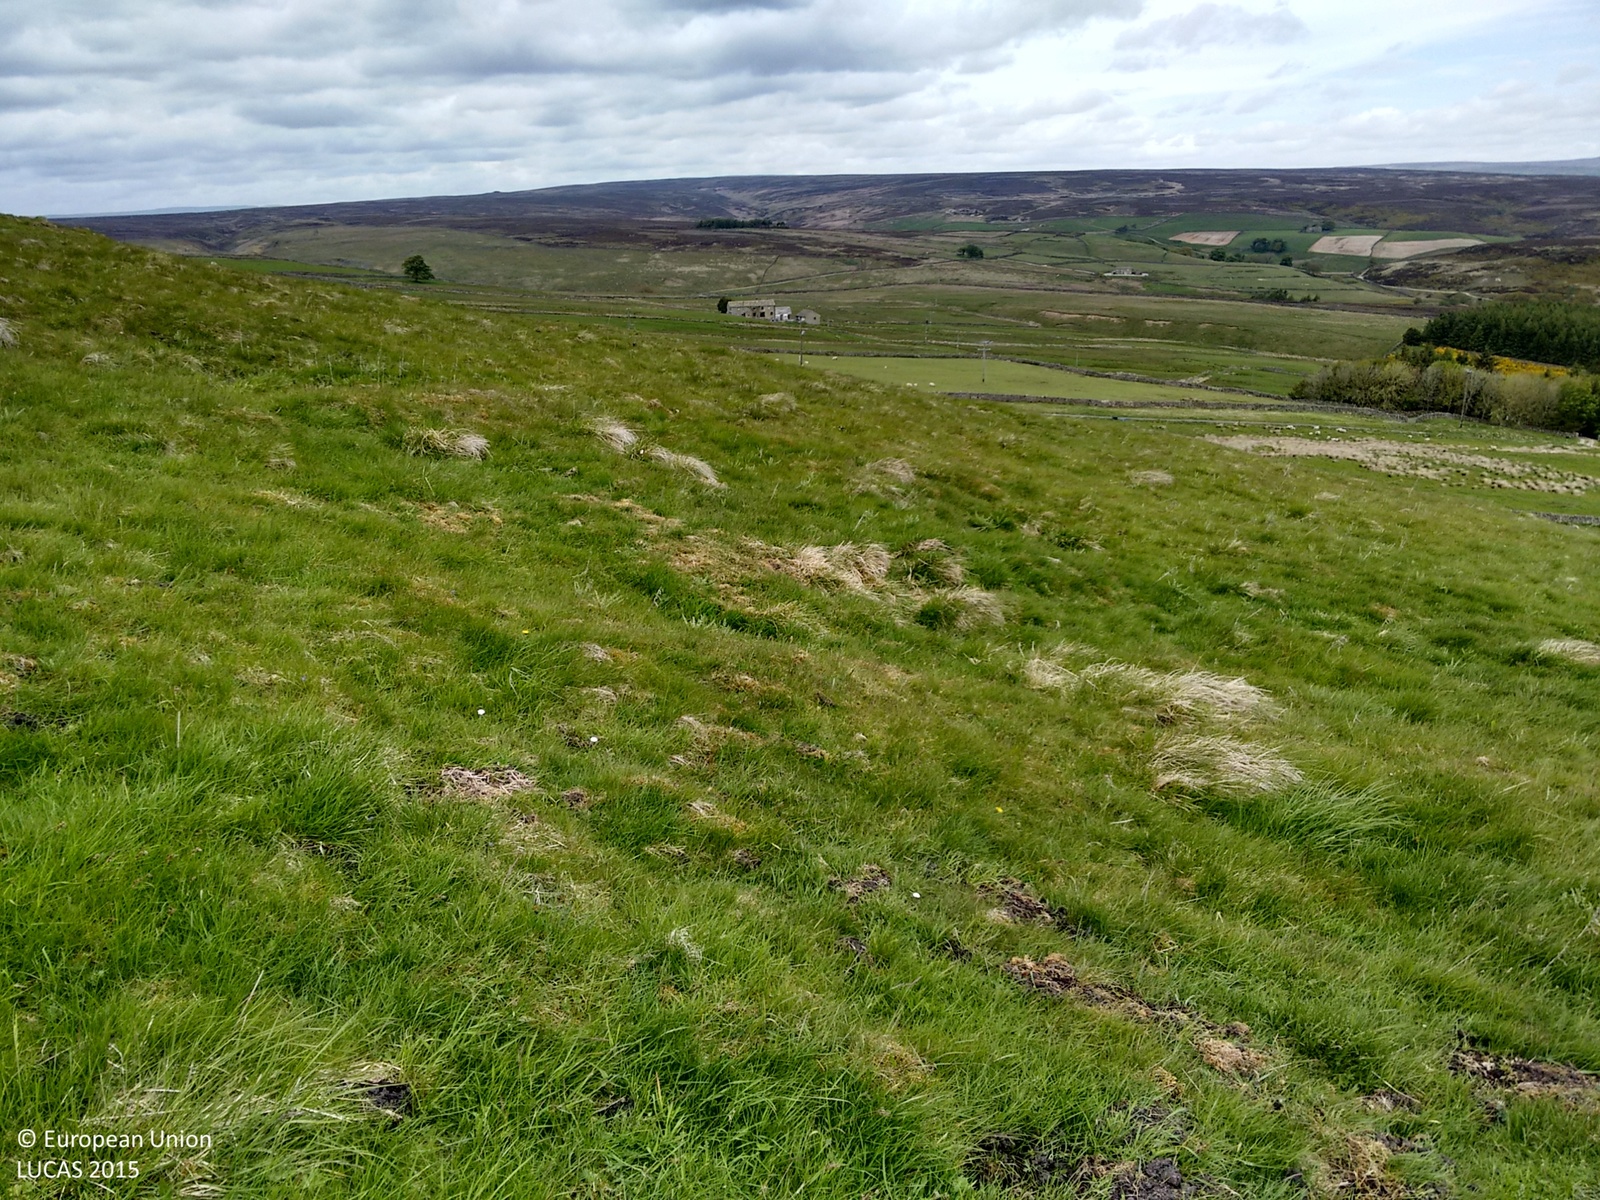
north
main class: Grassland
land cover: Grassland without tree/shrub cover
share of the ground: > 75 %
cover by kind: herbaceous plants 100 %
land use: Agriculture (excluding fallow land and kitchen gardens)
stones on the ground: < 10 %
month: June
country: GB
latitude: 54.0764
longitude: -1.8068
